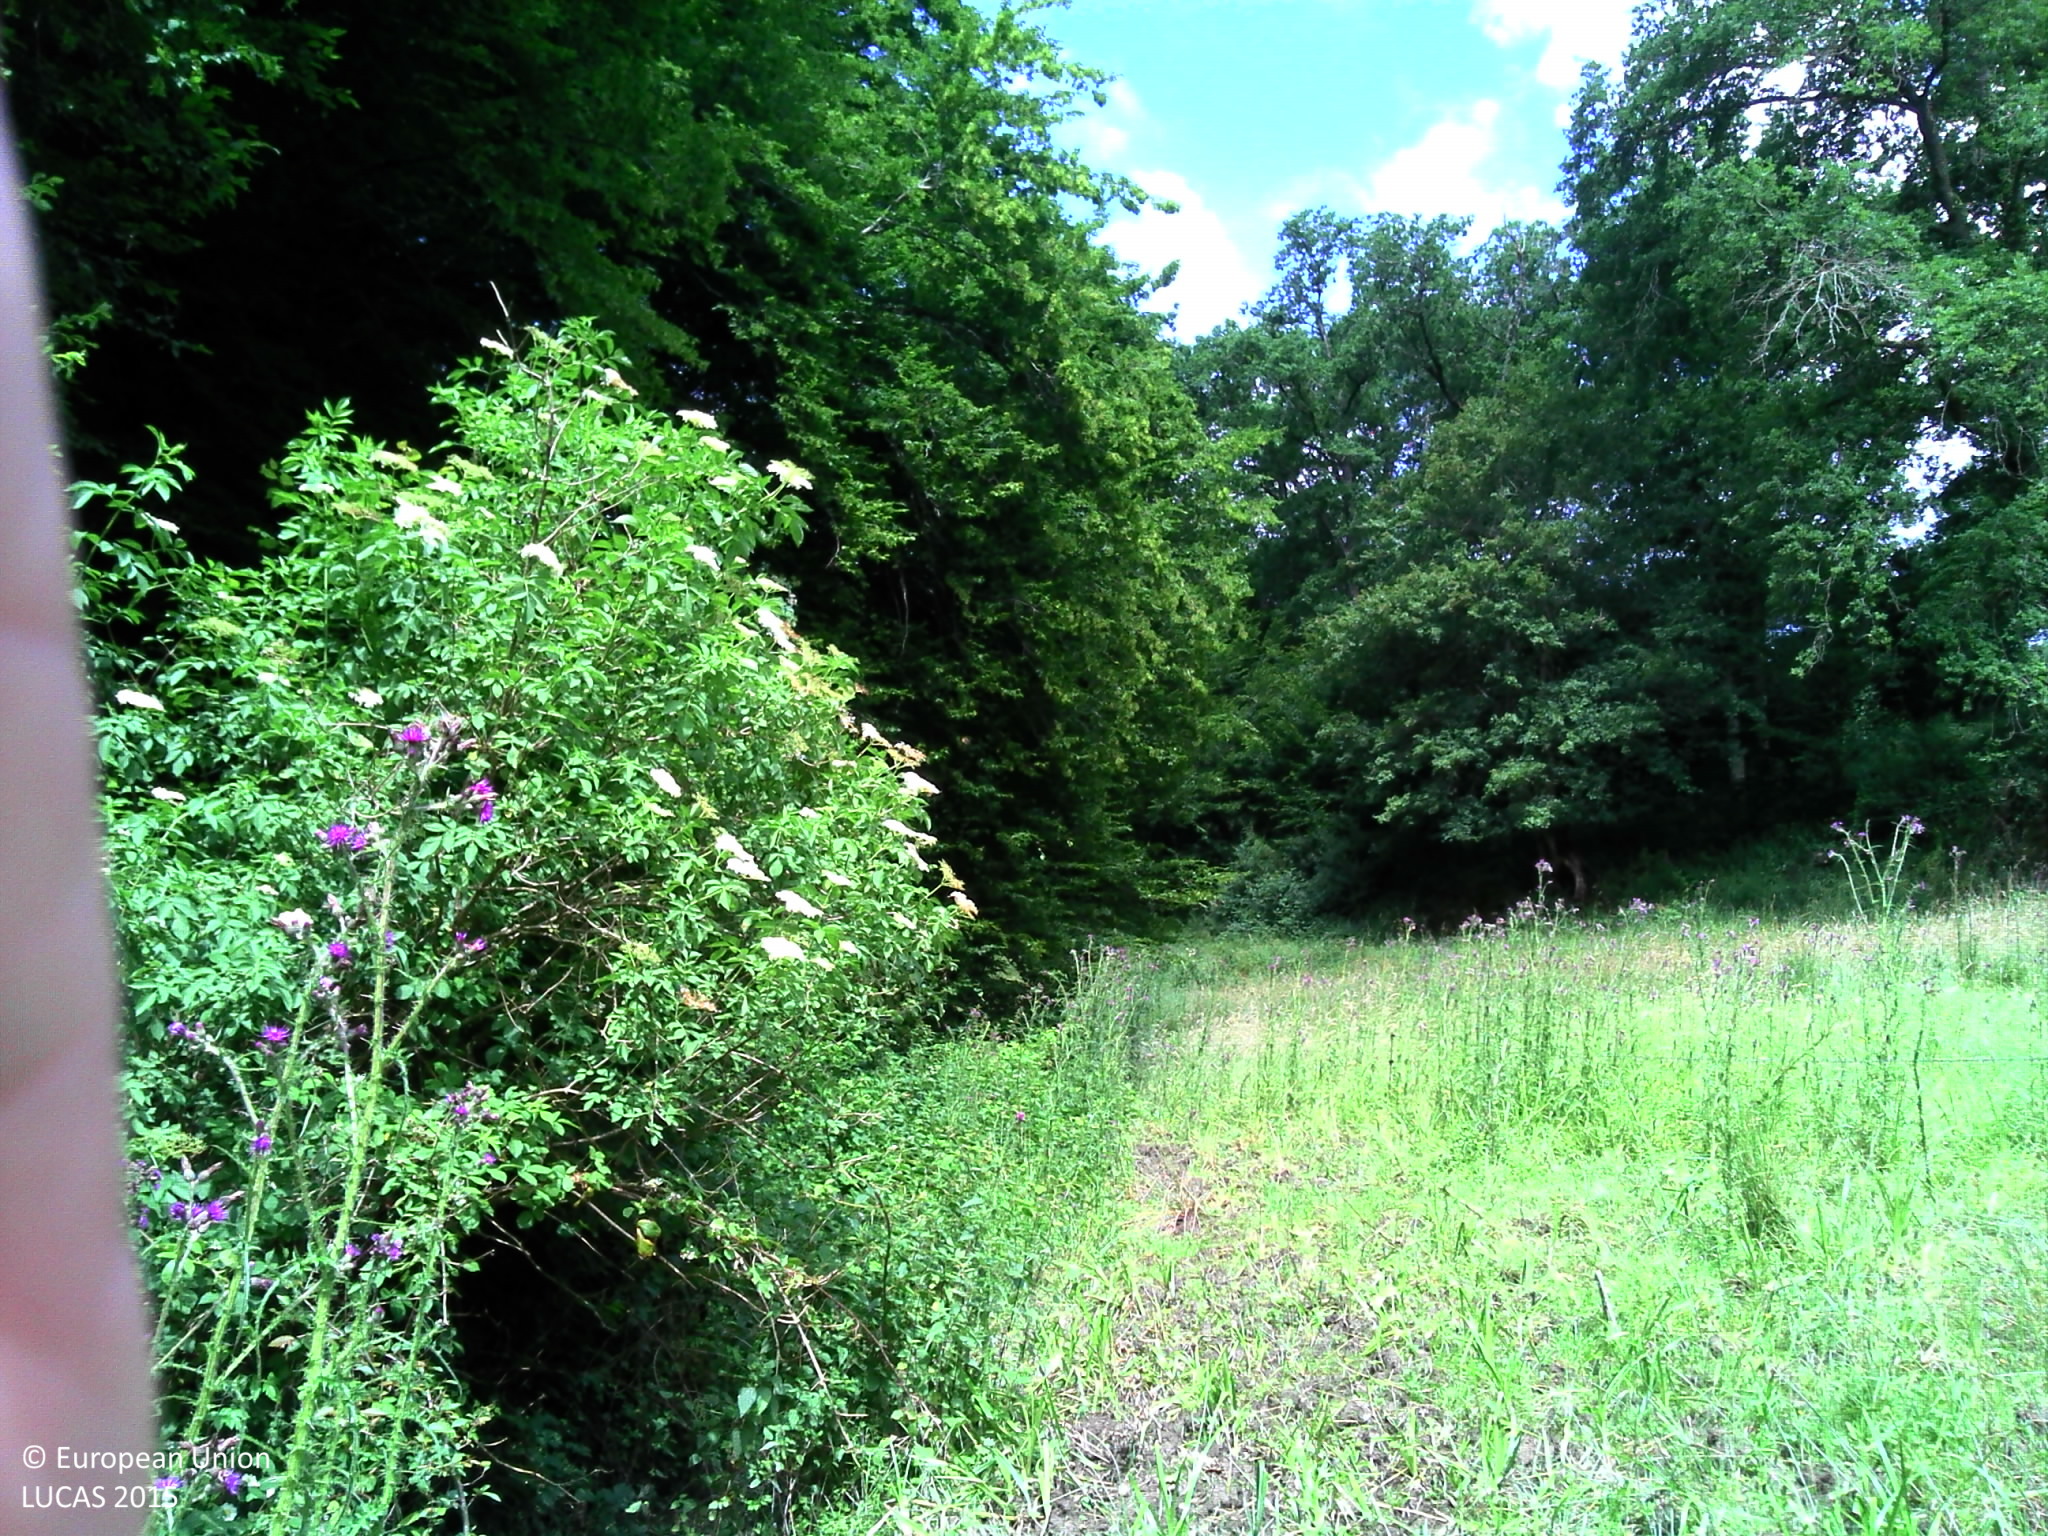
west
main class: Woodland
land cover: Broadleaved woodland
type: mesophytic deciduous forest
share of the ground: > 75 %
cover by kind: broadleaved forest trees 90 %, shrubs 10 %
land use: Forestry
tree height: > 5 m
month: June
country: FR
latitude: 46.2846
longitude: 3.0021
